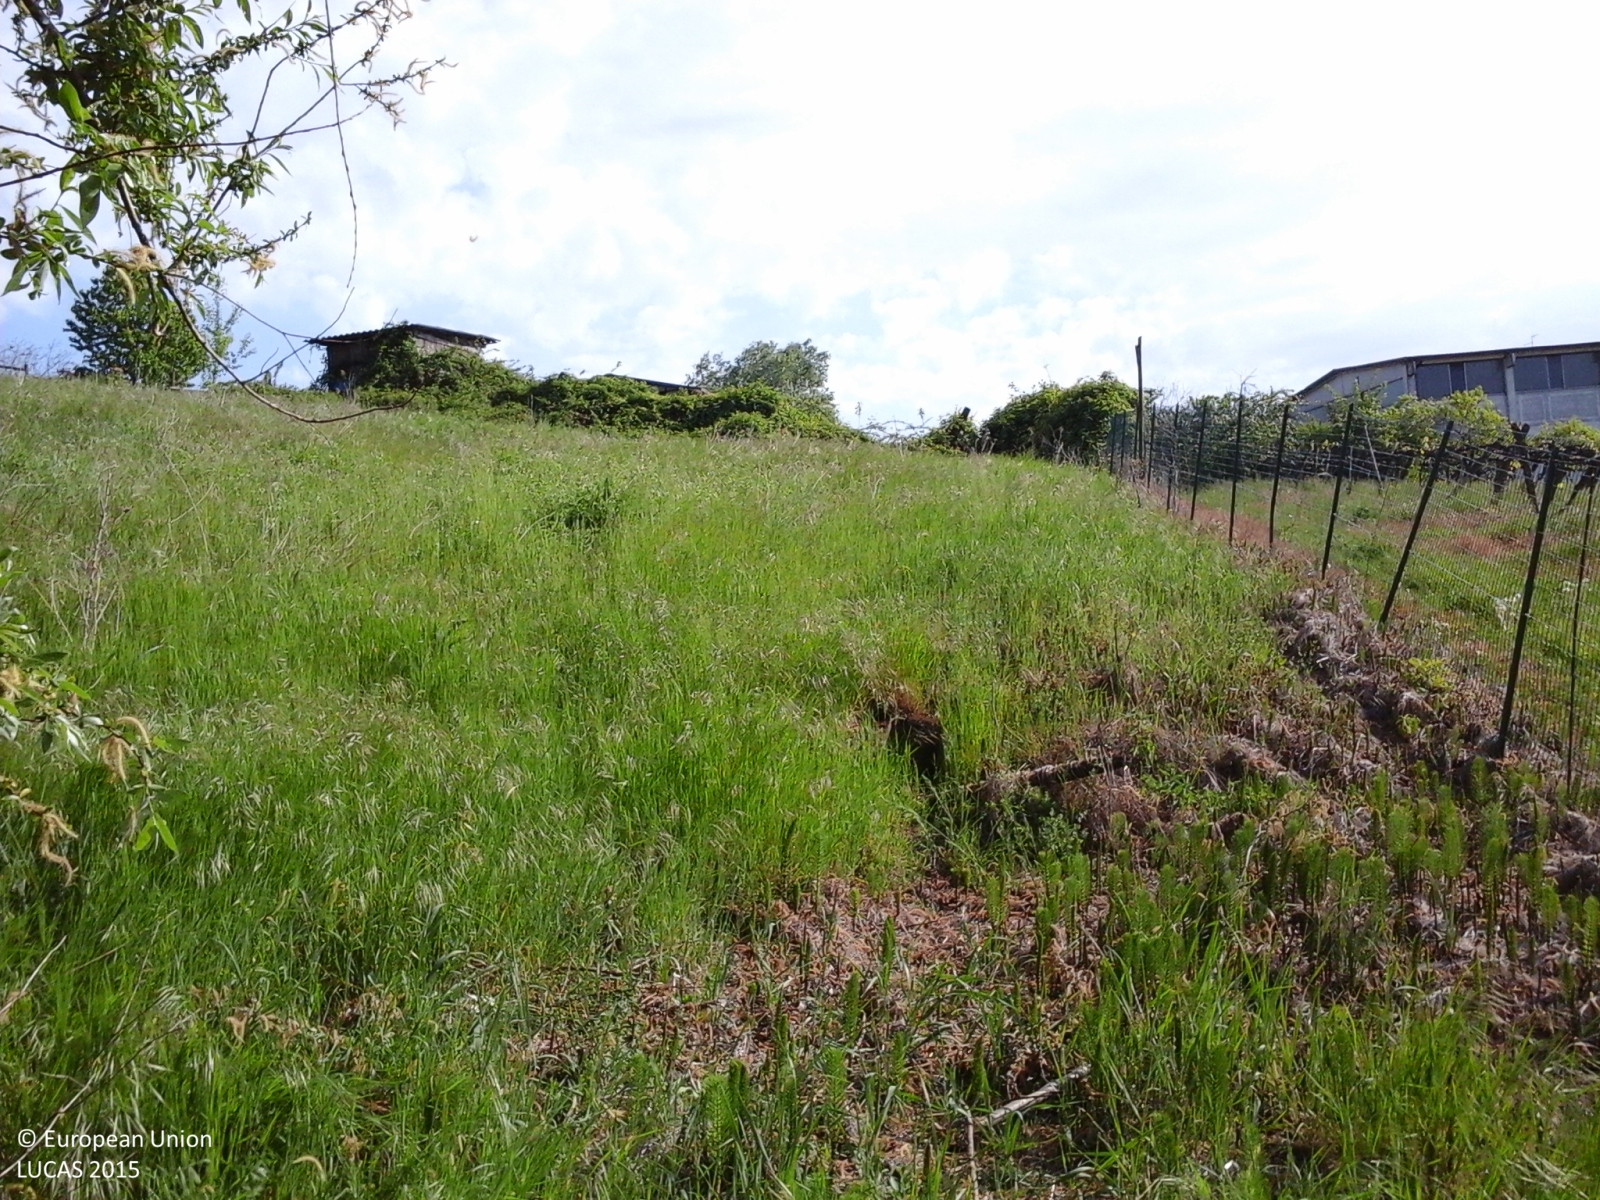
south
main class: Woodland
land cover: Broadleaved woodland
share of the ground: > 75 %
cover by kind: herbaceous plants 70 %, broadleaved forest trees 30 %
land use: Semi-natural and natural areas not in use
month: April
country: IT
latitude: 44.9979
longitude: 9.3796
